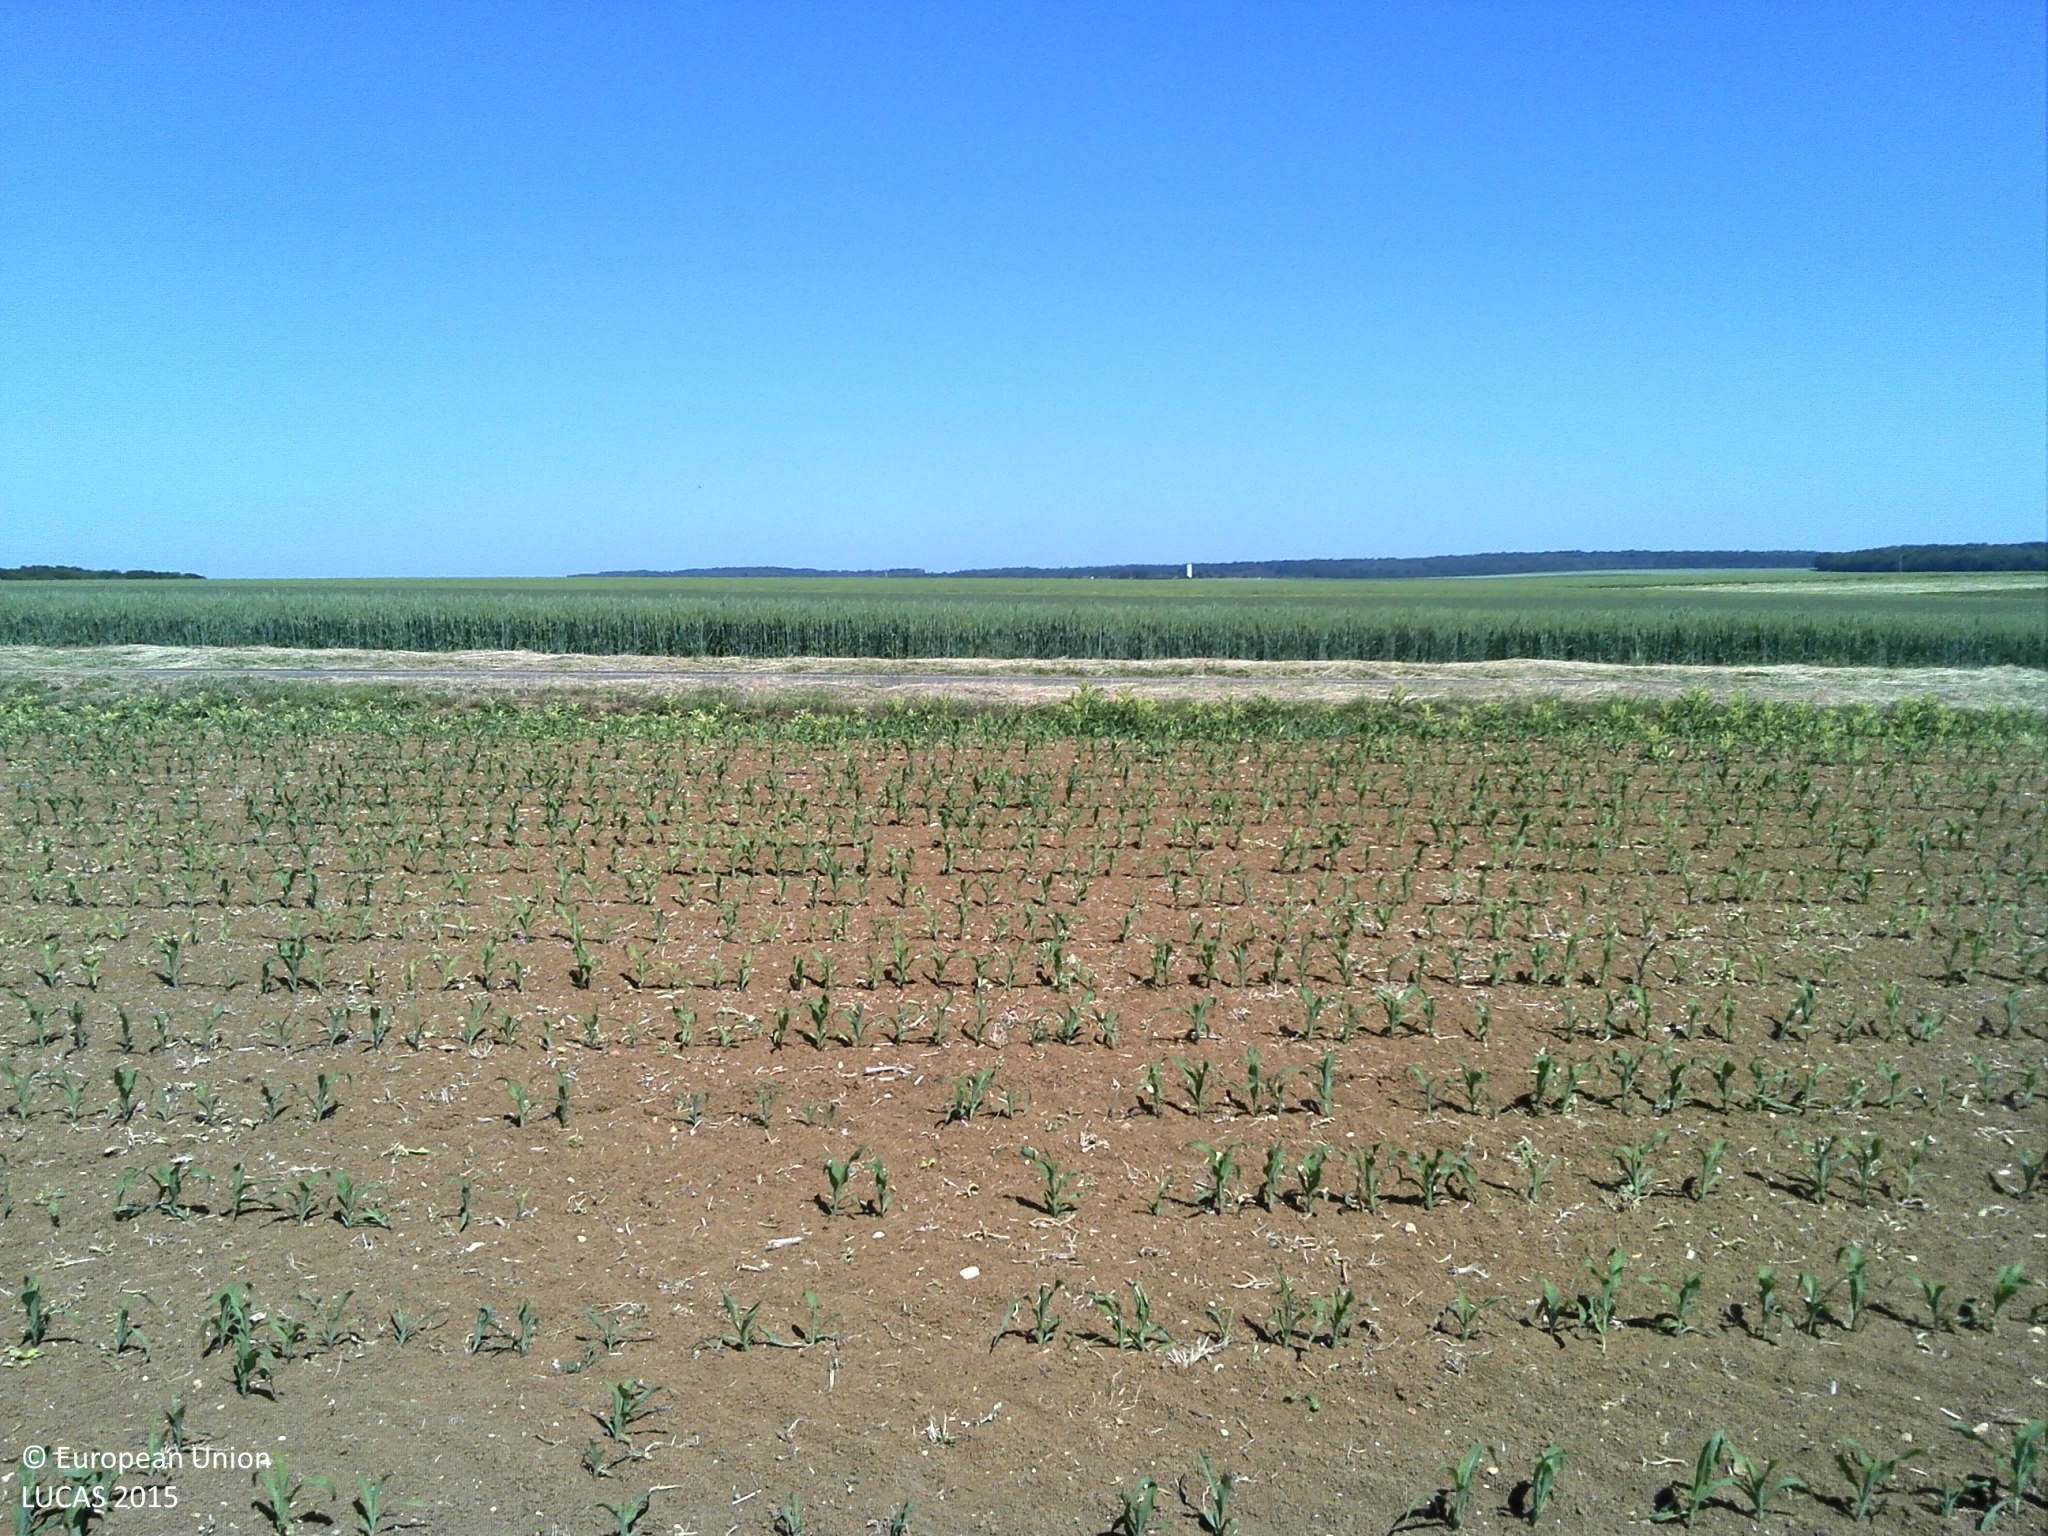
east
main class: Cropland
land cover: Maize
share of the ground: < 10 %
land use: Agriculture (excluding fallow land and kitchen gardens)
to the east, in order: Maize; Grass margins; Paved roads, cycling and walking lanes; Grass margins; Common wheat; Grass margins; Rape and turnip rape
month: June
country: FR
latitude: 49.1052
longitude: 5.9860
